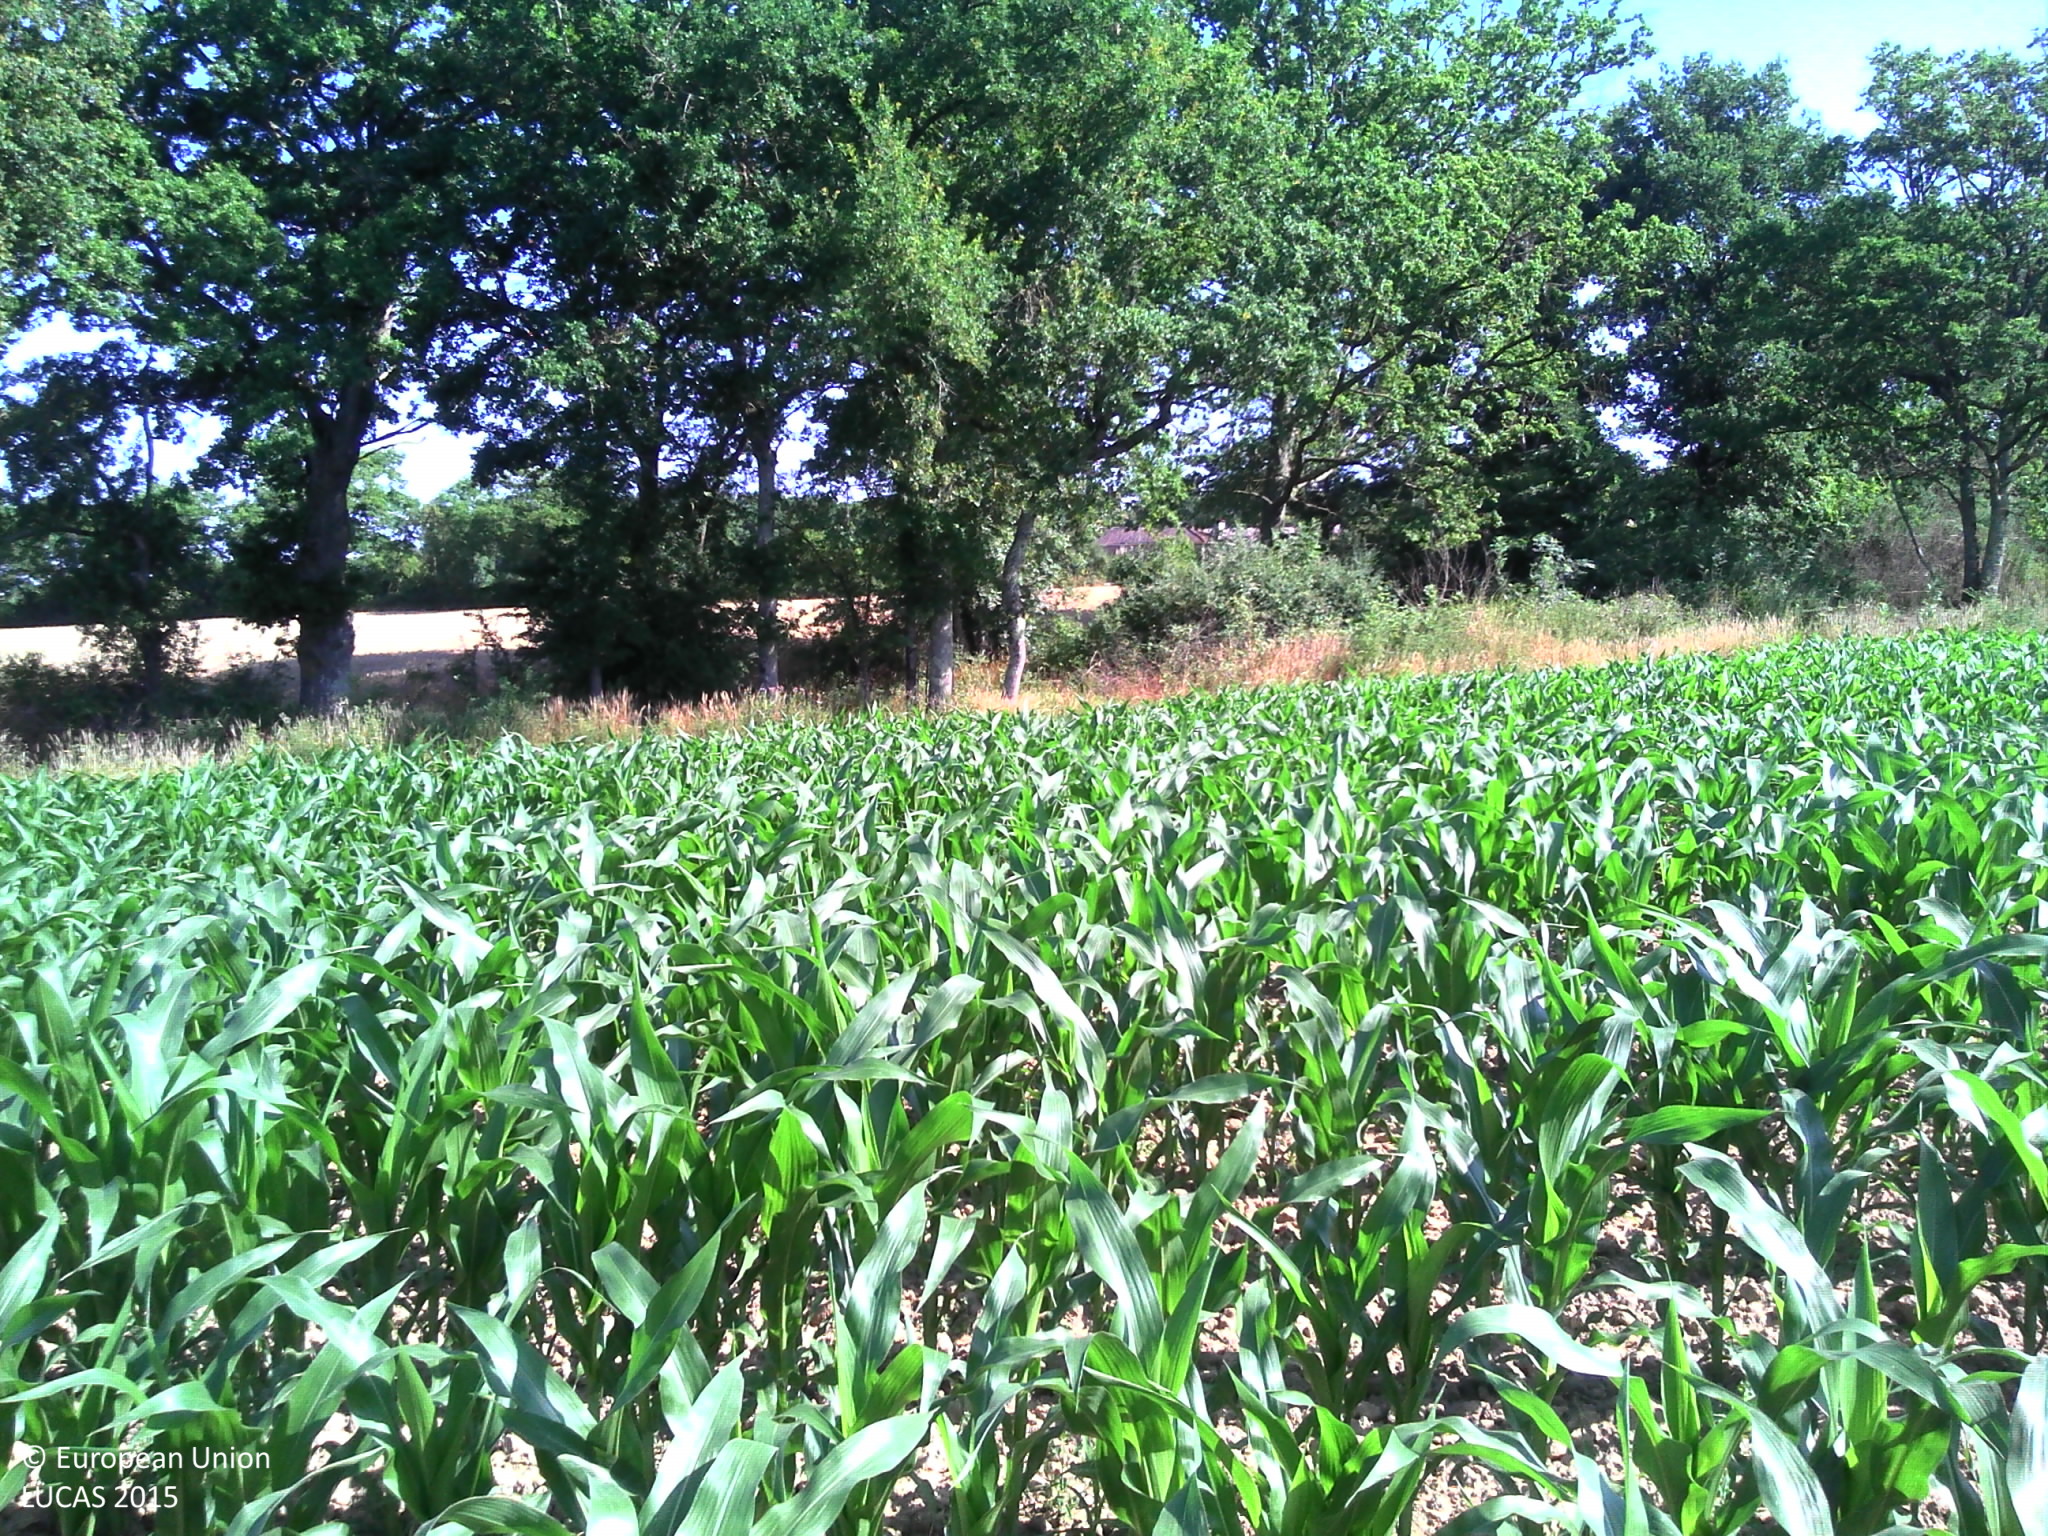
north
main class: Cropland
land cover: Maize
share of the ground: > 75 %
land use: Agriculture (excluding fallow land and kitchen gardens)
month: July
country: FR
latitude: 46.3078
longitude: 0.9103
